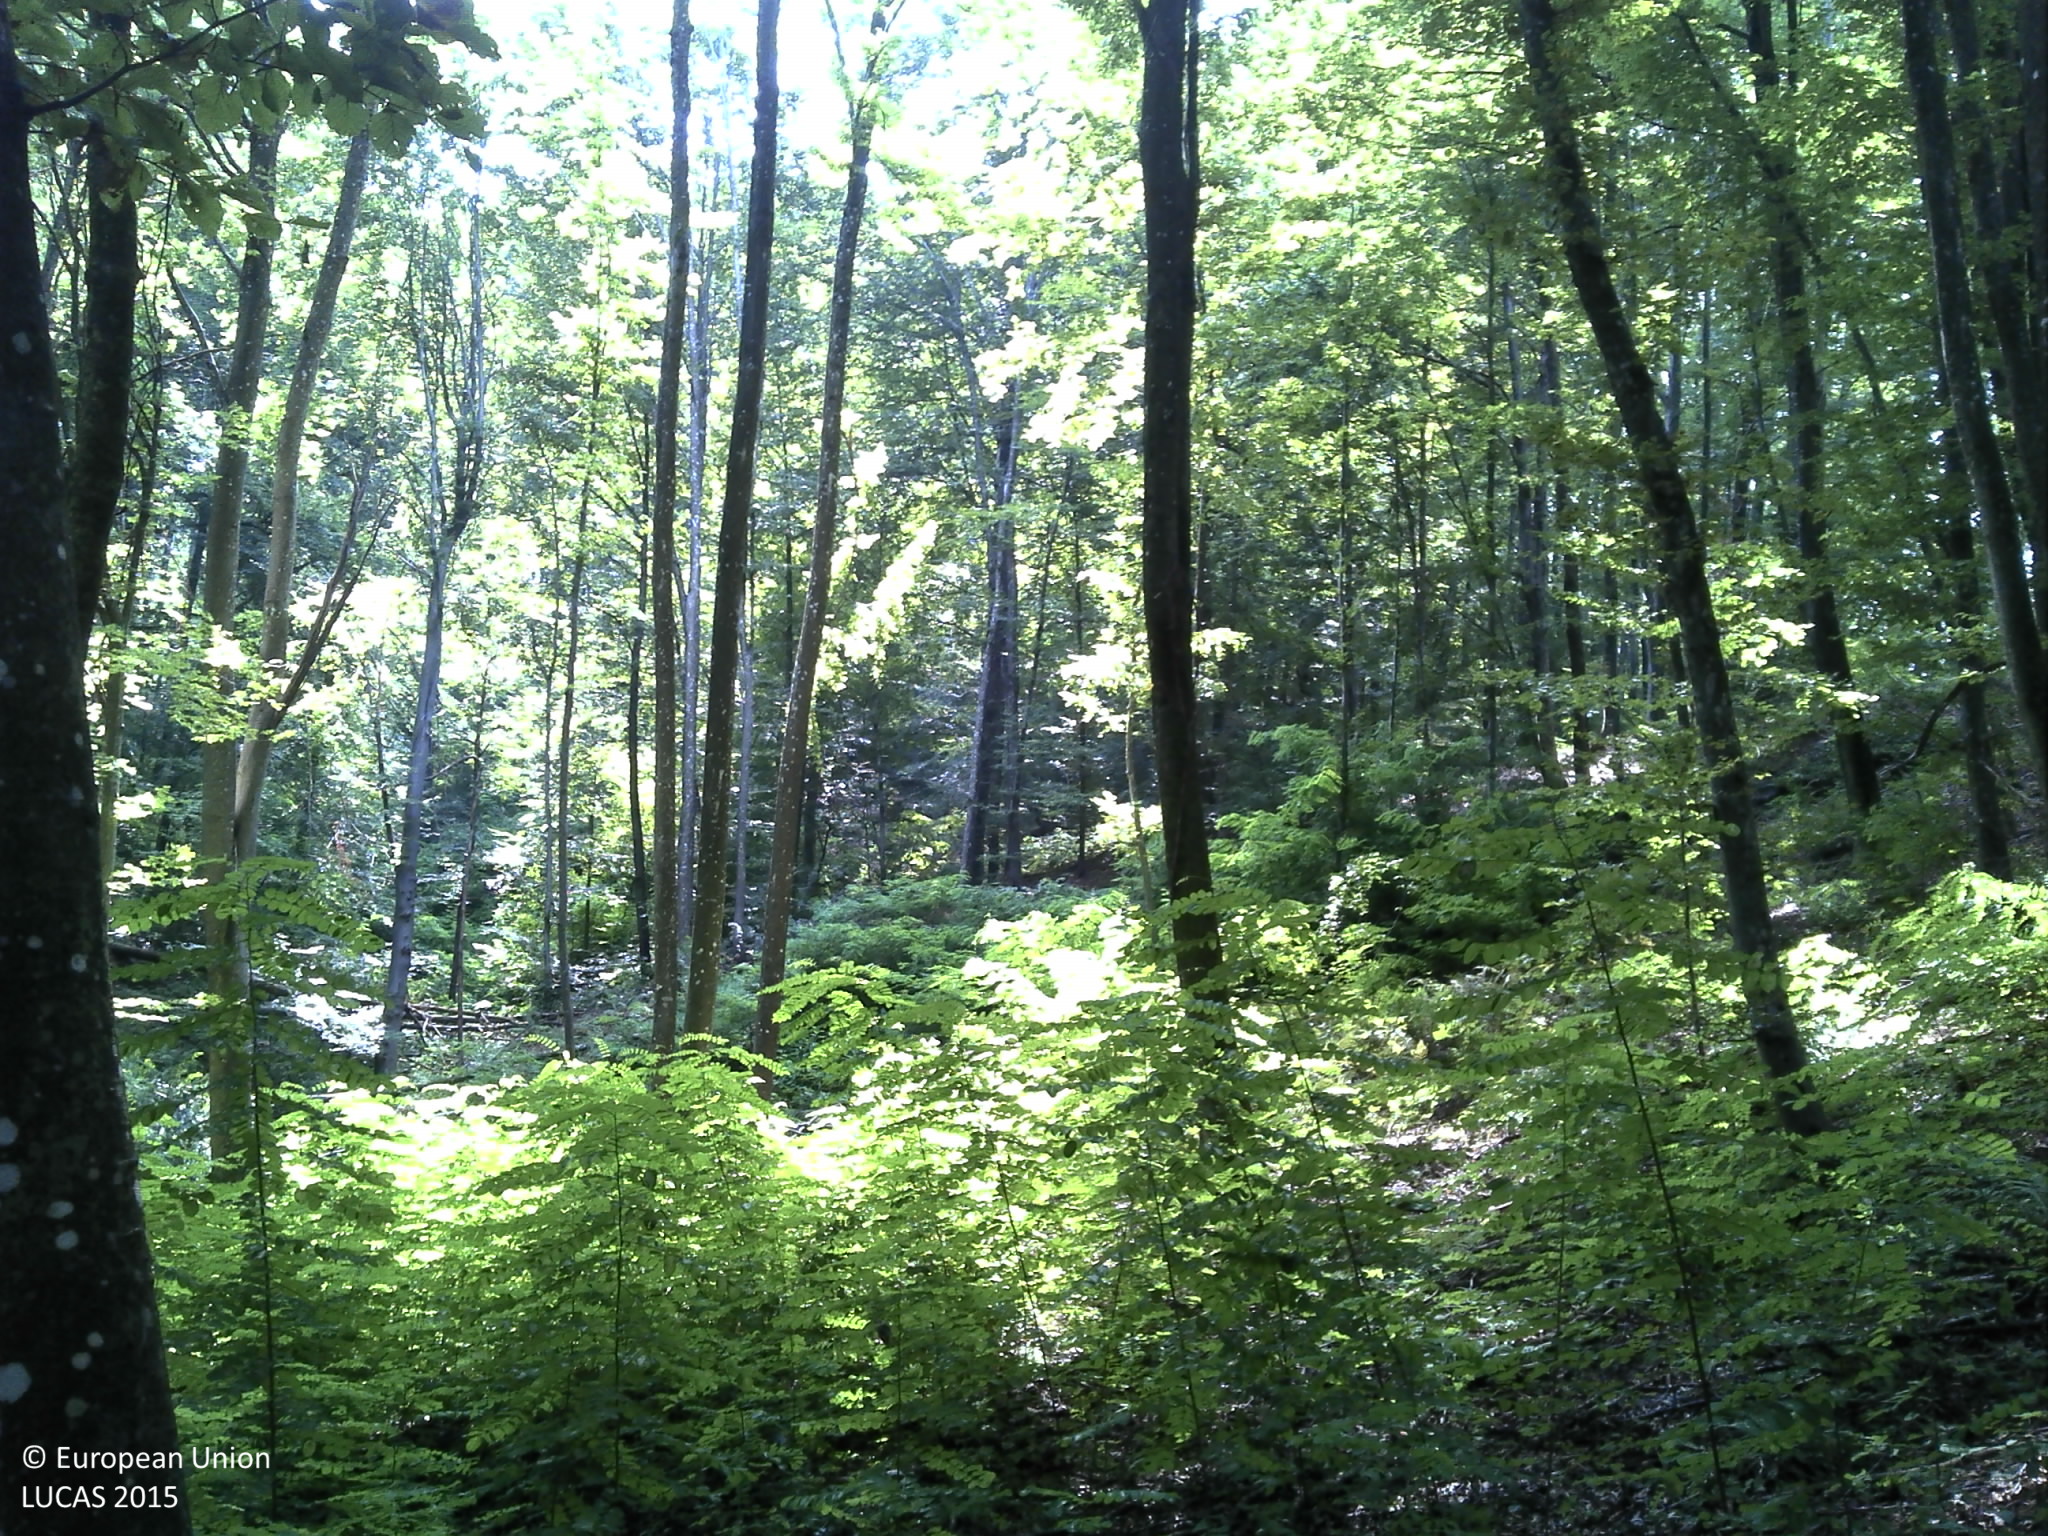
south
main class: Woodland
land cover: Broadleaved woodland
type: beech forest
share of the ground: > 75 %
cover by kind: broadleaved forest trees 100 %
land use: Forestry
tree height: > 5 m
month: August
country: HR
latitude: 45.3462
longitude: 15.7778
